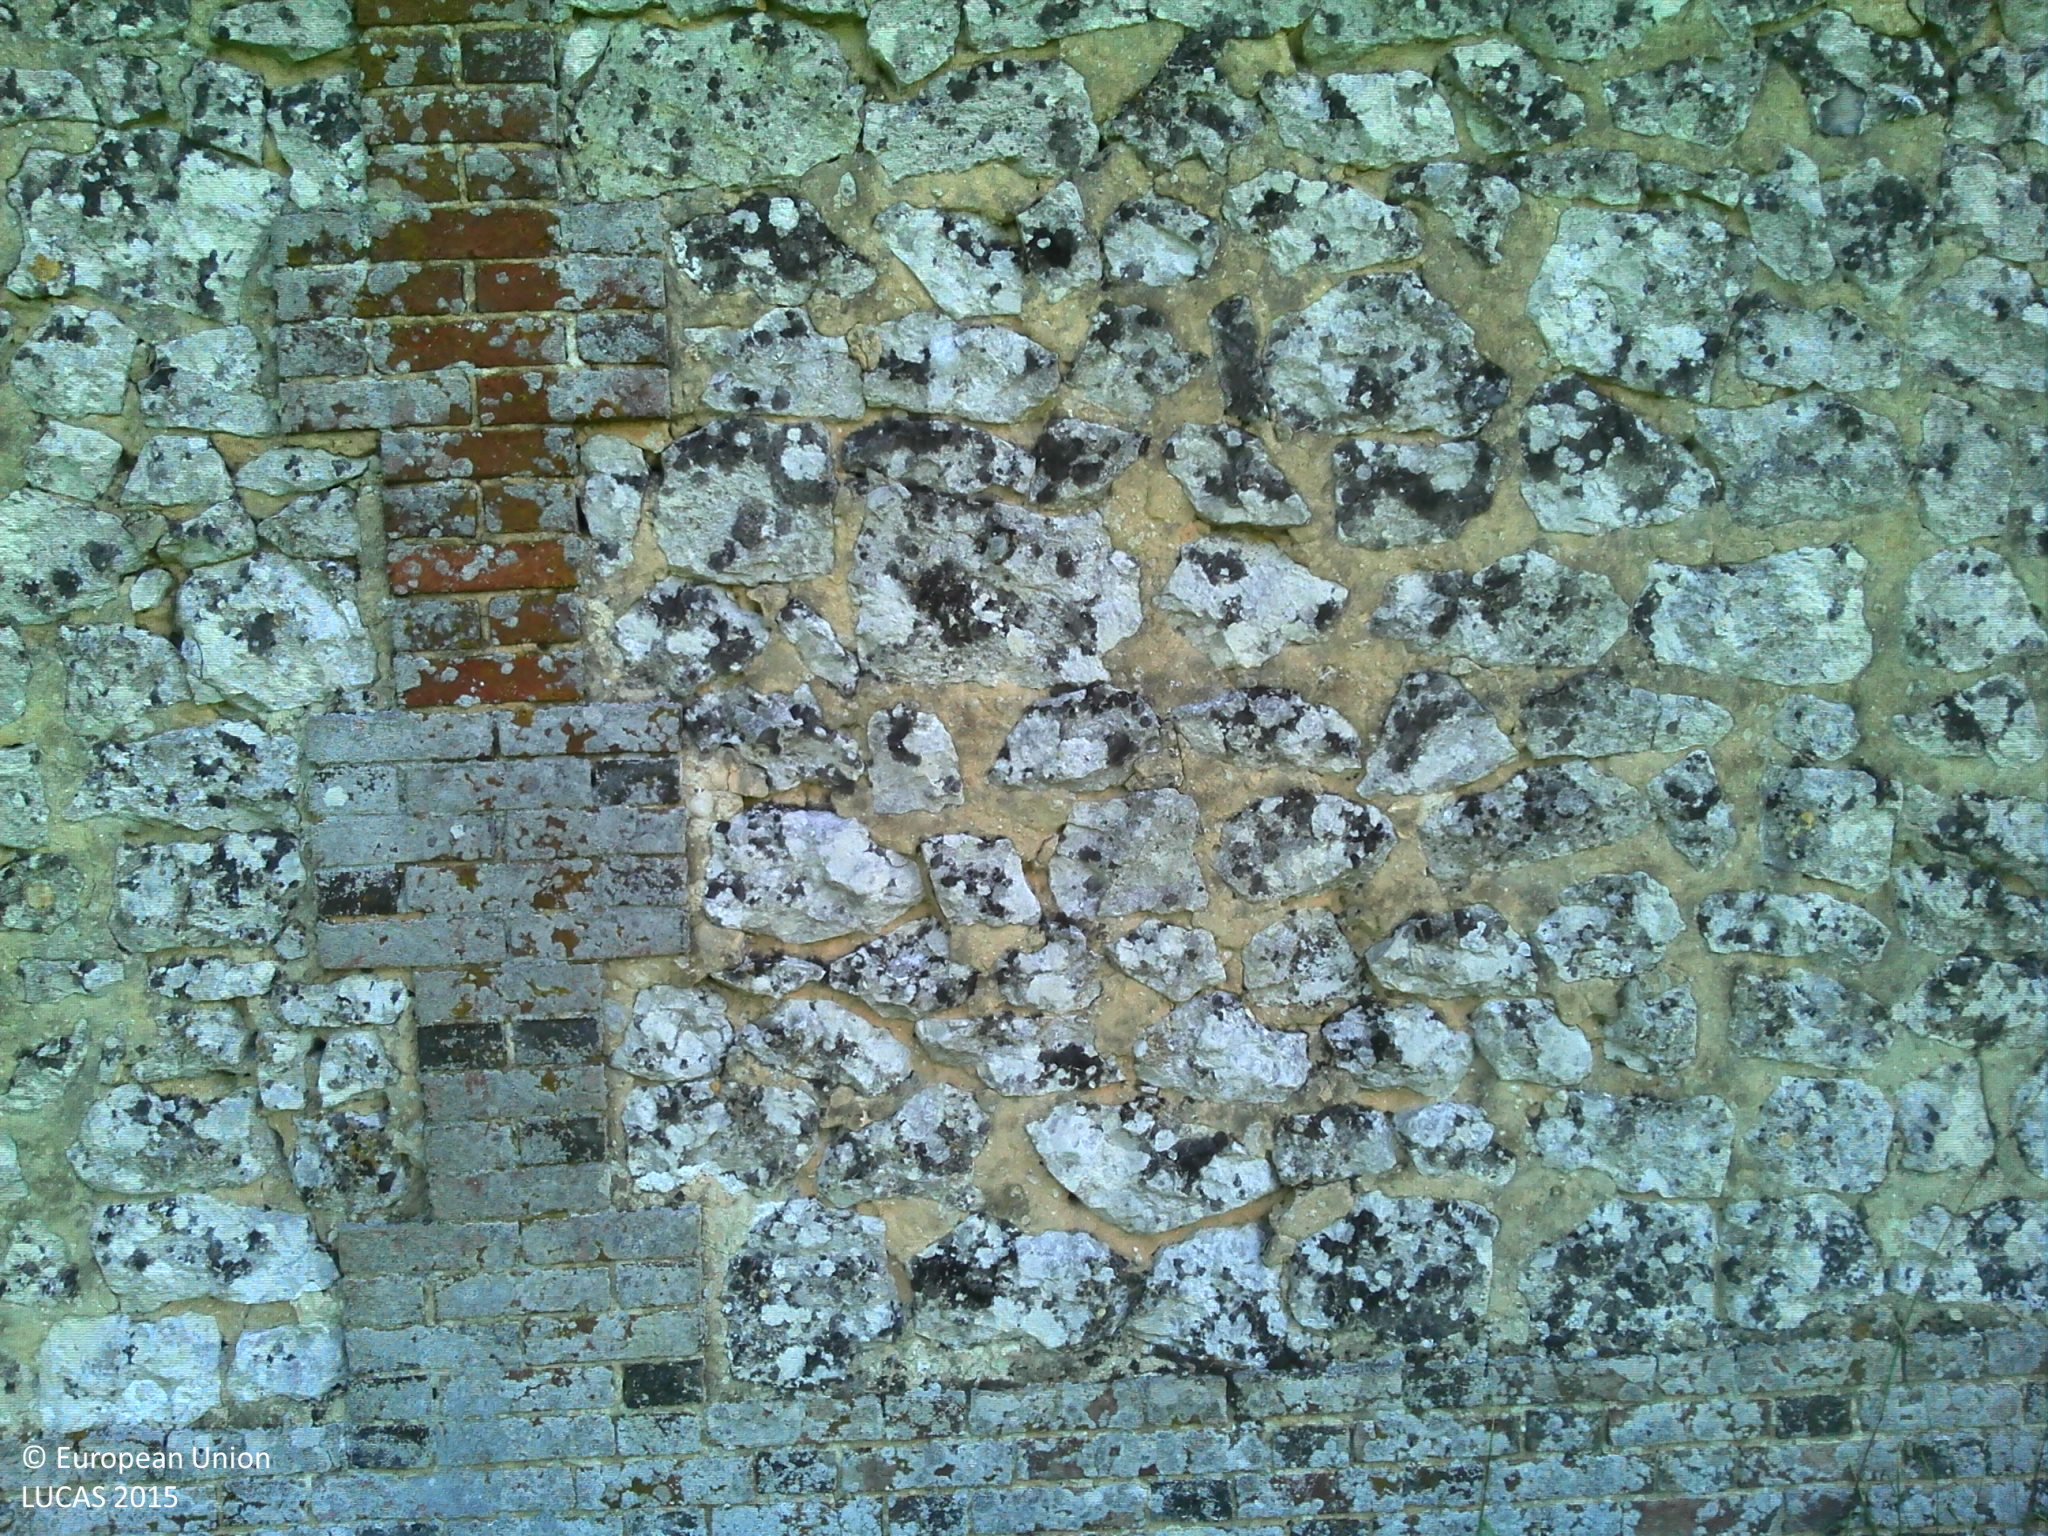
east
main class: Woodland
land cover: Broadleaved woodland
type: mesophytic deciduous forest
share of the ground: > 75 %
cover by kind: broadleaved forest trees 80 %, herbaceous plants 10 %, consolidated bare surface 10 %
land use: Forestry
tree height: > 5 m
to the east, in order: Broadleaved woodland; Dry stone walls; Tracks; Lines of trees; Fences; Grassland without tree/shrub cover; Lines of trees
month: June
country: FR
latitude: 49.1087
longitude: 1.0608
